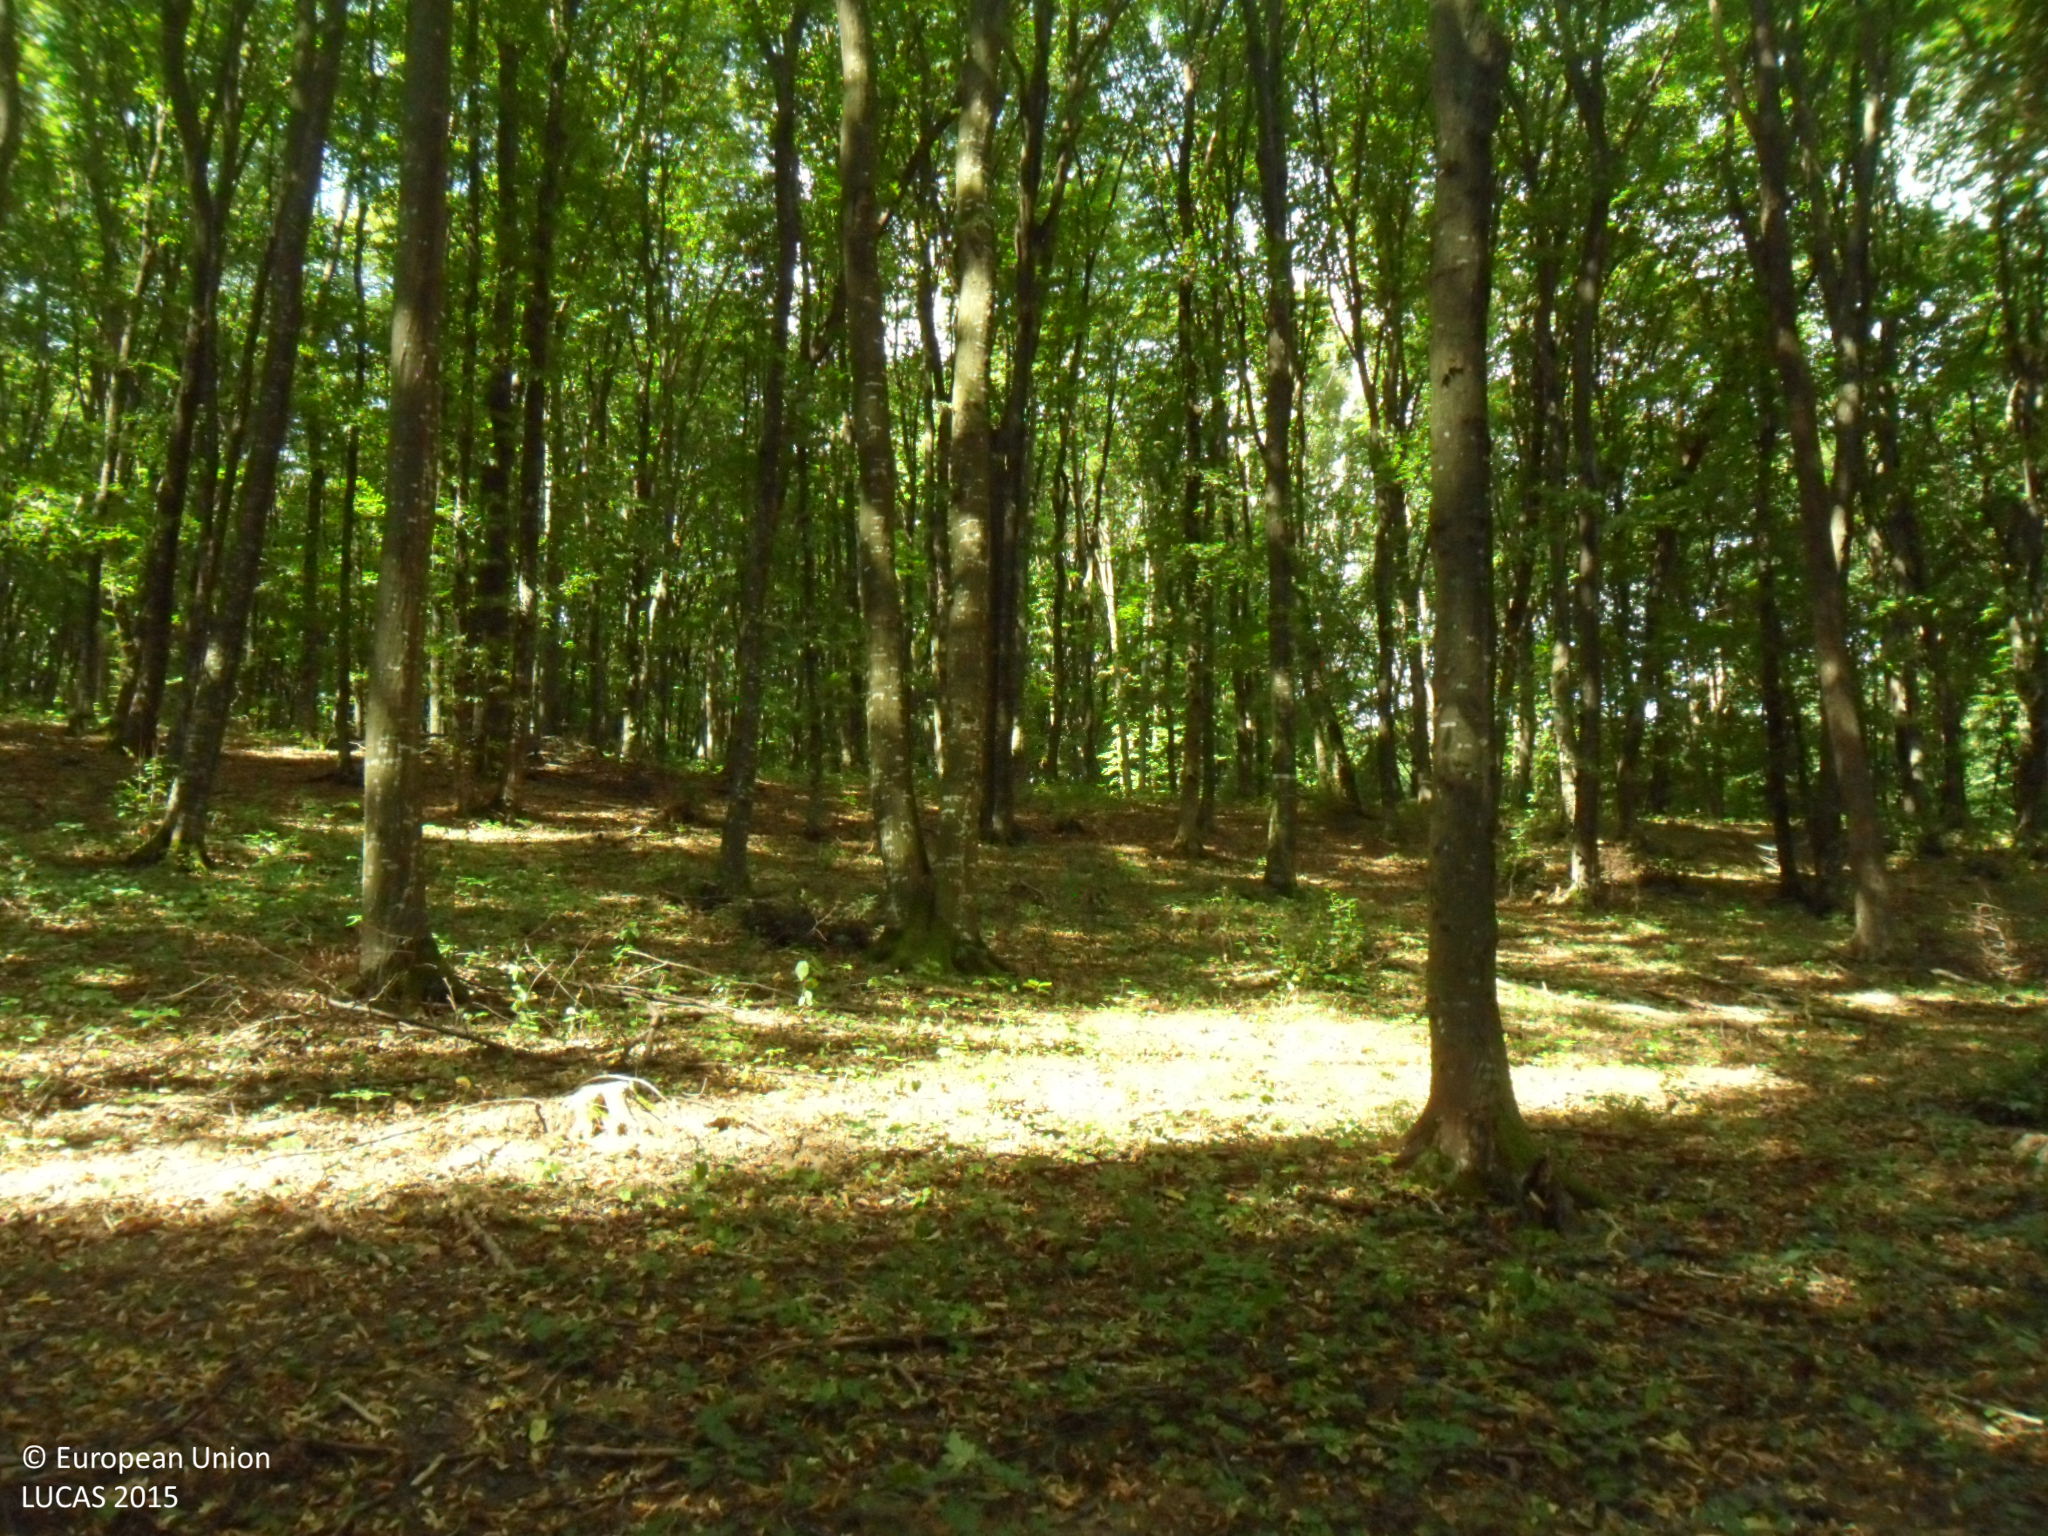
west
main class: Woodland
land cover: Broadleaved woodland
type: beech forest
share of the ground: > 75 %
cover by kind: broadleaved forest trees 100 %
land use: Forestry
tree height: > 5 m
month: September
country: BG
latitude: 43.5684
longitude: 26.2827
